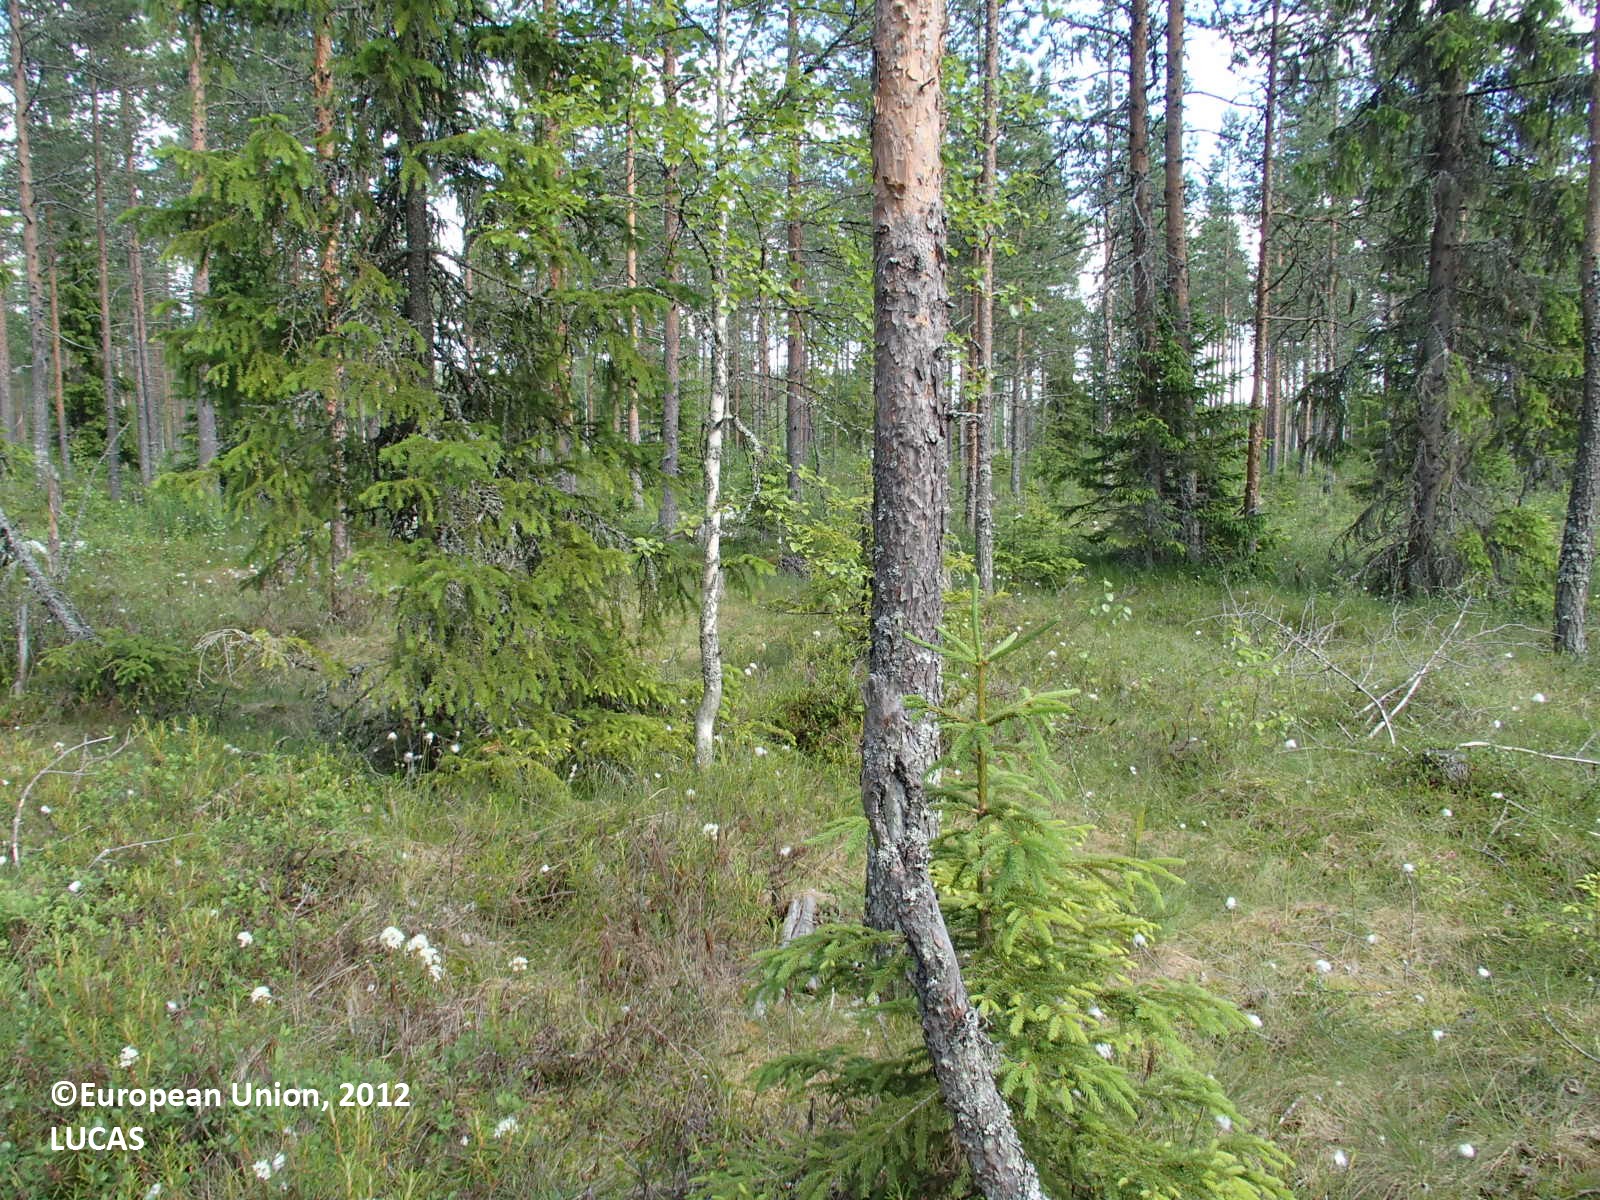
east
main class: Woodland
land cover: Pine dominated coniferous woodland
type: boreal forest
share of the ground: > 75 %
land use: Forestry
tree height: > 5 m
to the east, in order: Pine dominated coniferous woodland; Ditches and canals; Pine dominated coniferous woodland; Ditches and canals; Pine dominated coniferous woodland; Ditches and canals; Pine dominated coniferous woodland; Ditches and canals; Pine dominated coniferous woodland; Ditches and canals; Broadleaved woodland; Other mixed woodland; Broadleaved woodland; Ditches and canals; Abandoned hedges; Paved roads, cycling and walking lanes; Abandoned hedges; Ditches and canals; Other mixed woodland
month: June
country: FI
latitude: 64.0165
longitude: 26.9284
